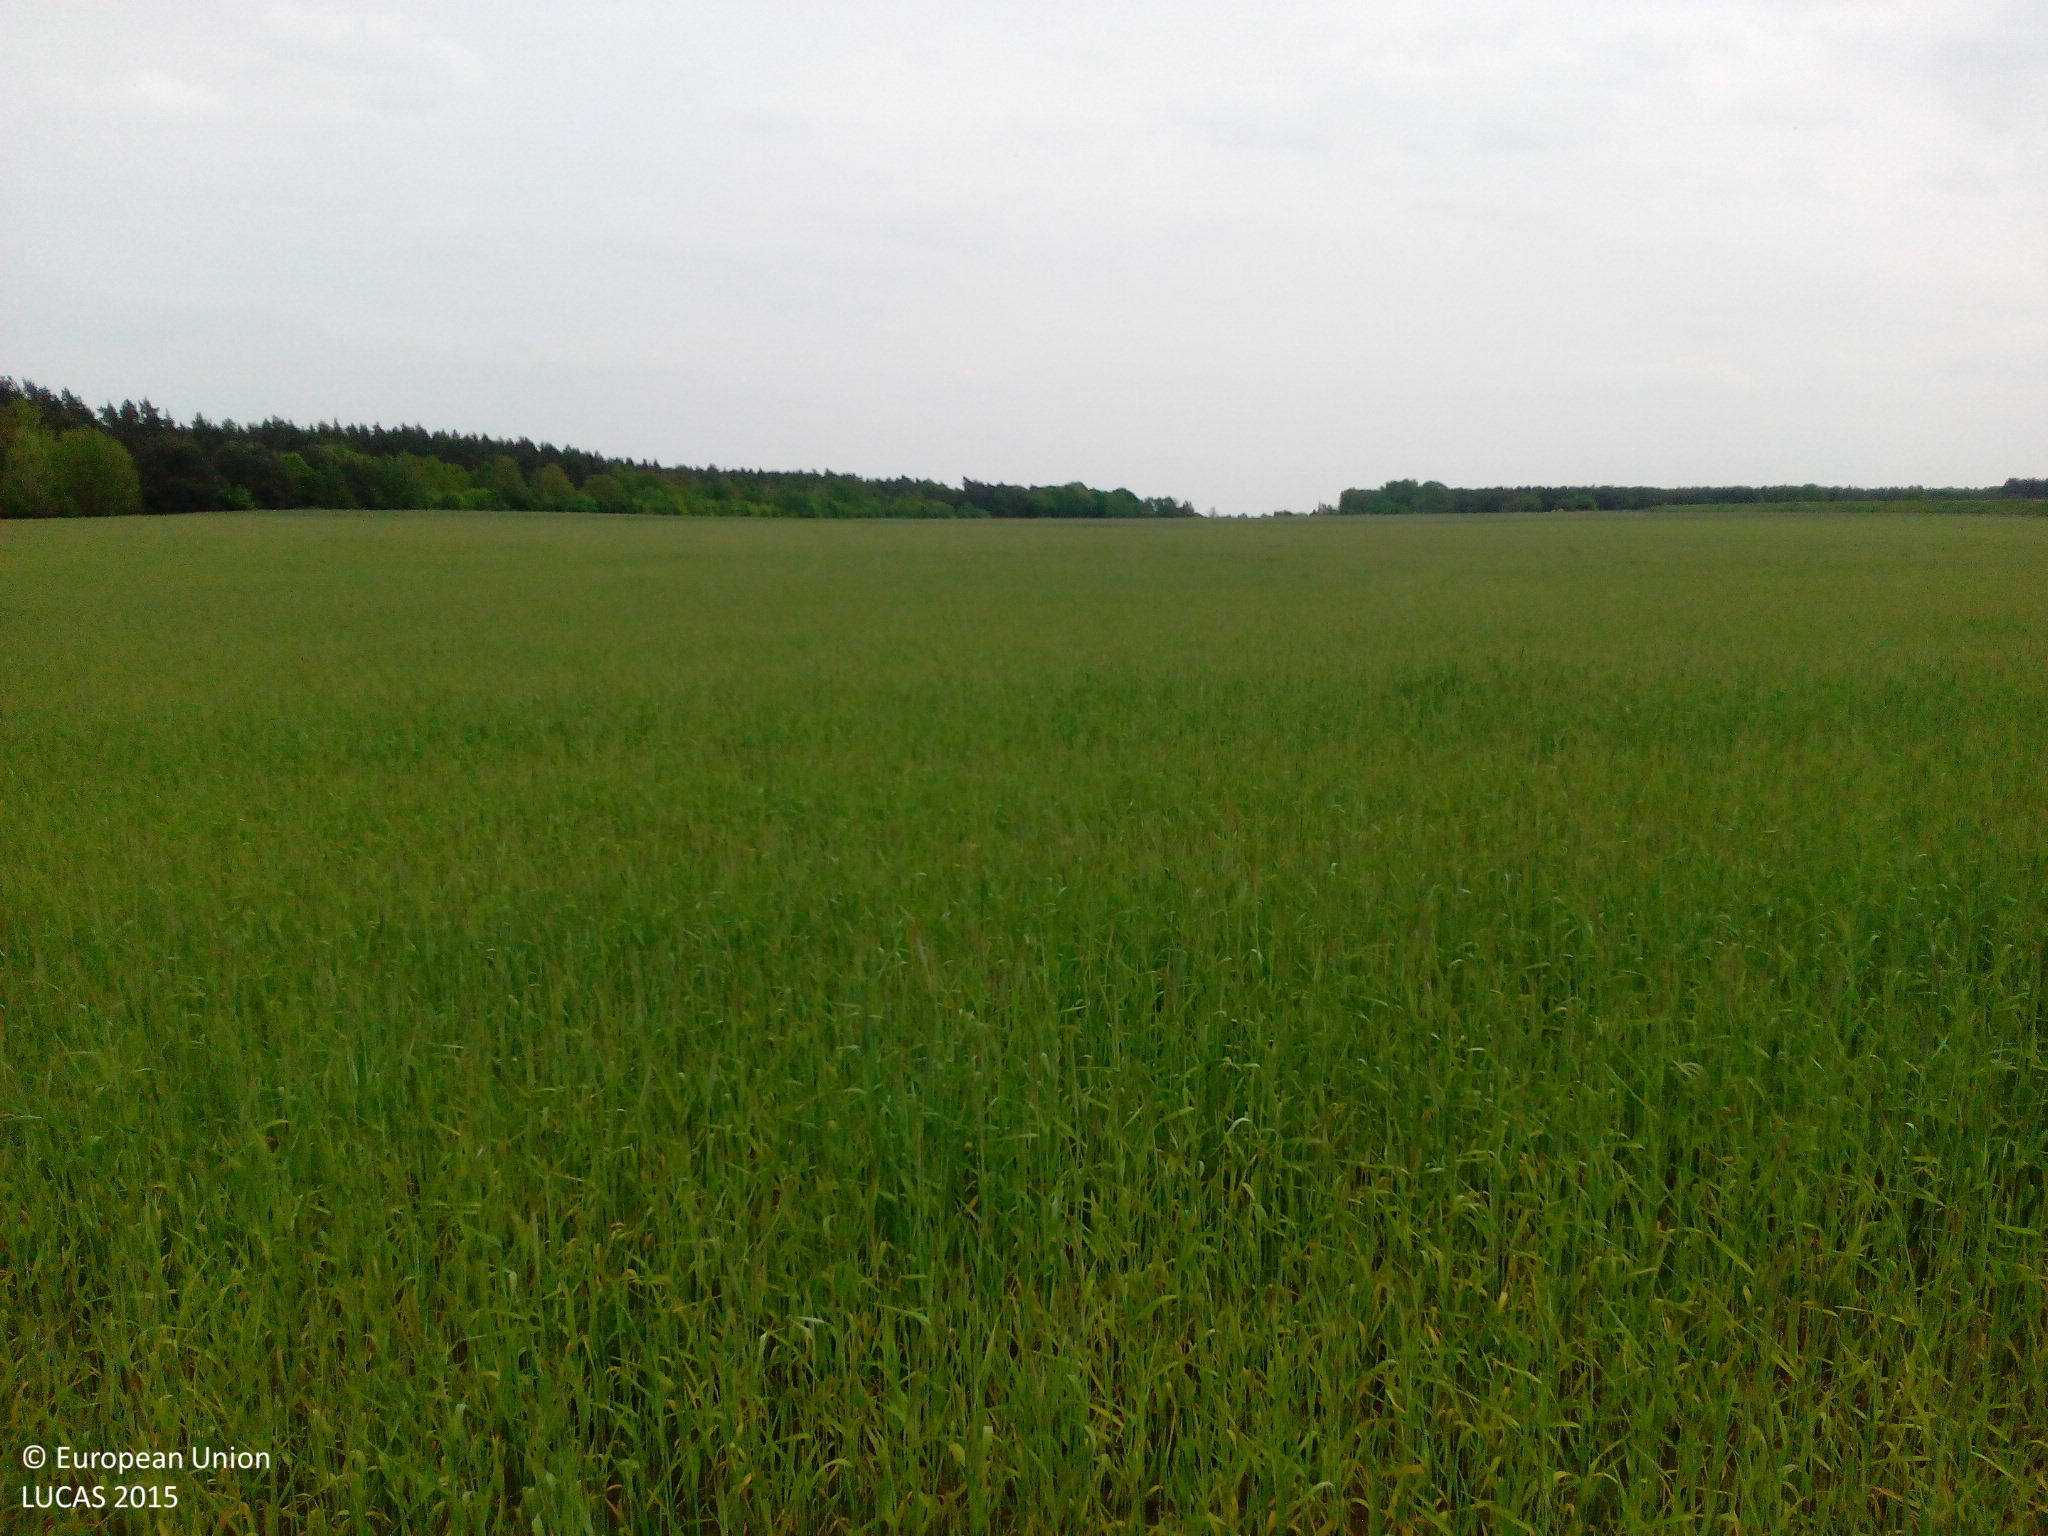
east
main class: Cropland
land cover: Rye
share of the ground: 10 - 25 %
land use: Agriculture (excluding fallow land and kitchen gardens)
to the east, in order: Rye
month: May
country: DE
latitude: 52.8578
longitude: 11.0838
